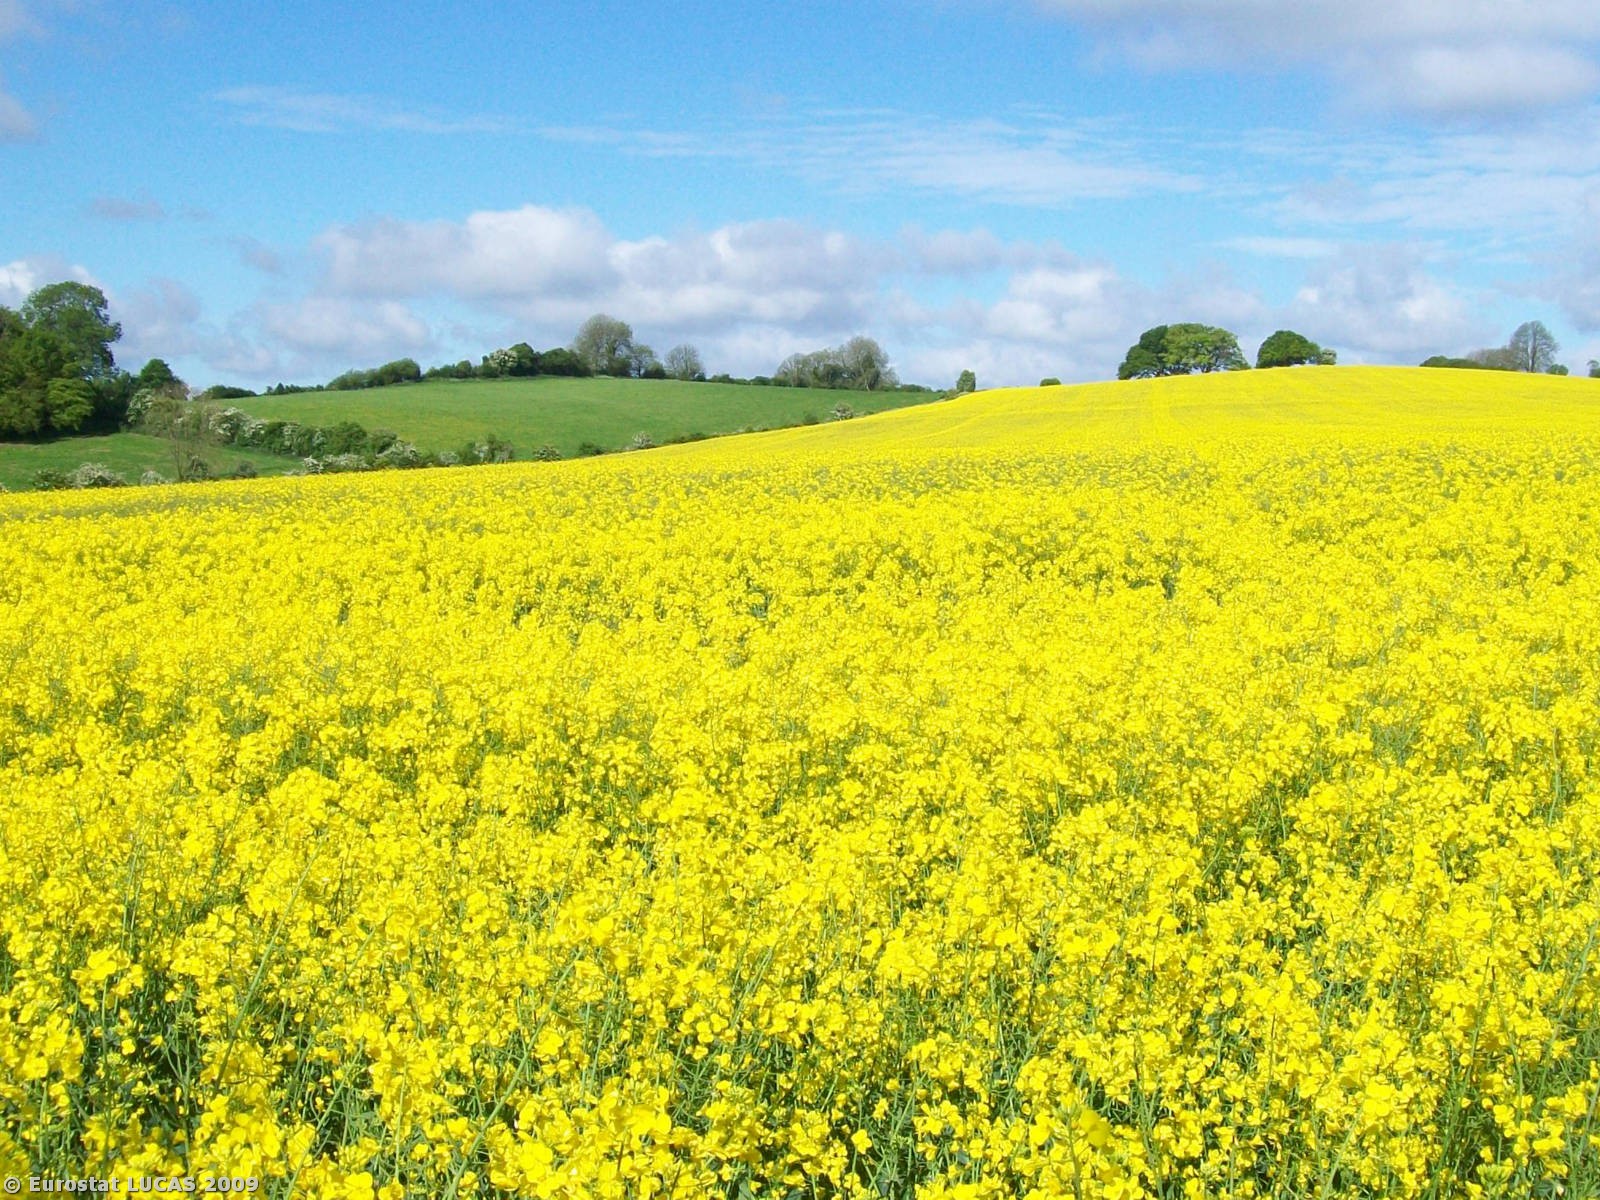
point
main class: Cropland
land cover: Rape and turnip rape
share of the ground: > 75 %
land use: Agriculture (excluding fallow land and kitchen gardens)
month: May
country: GB
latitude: 51.0922
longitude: -2.1833
